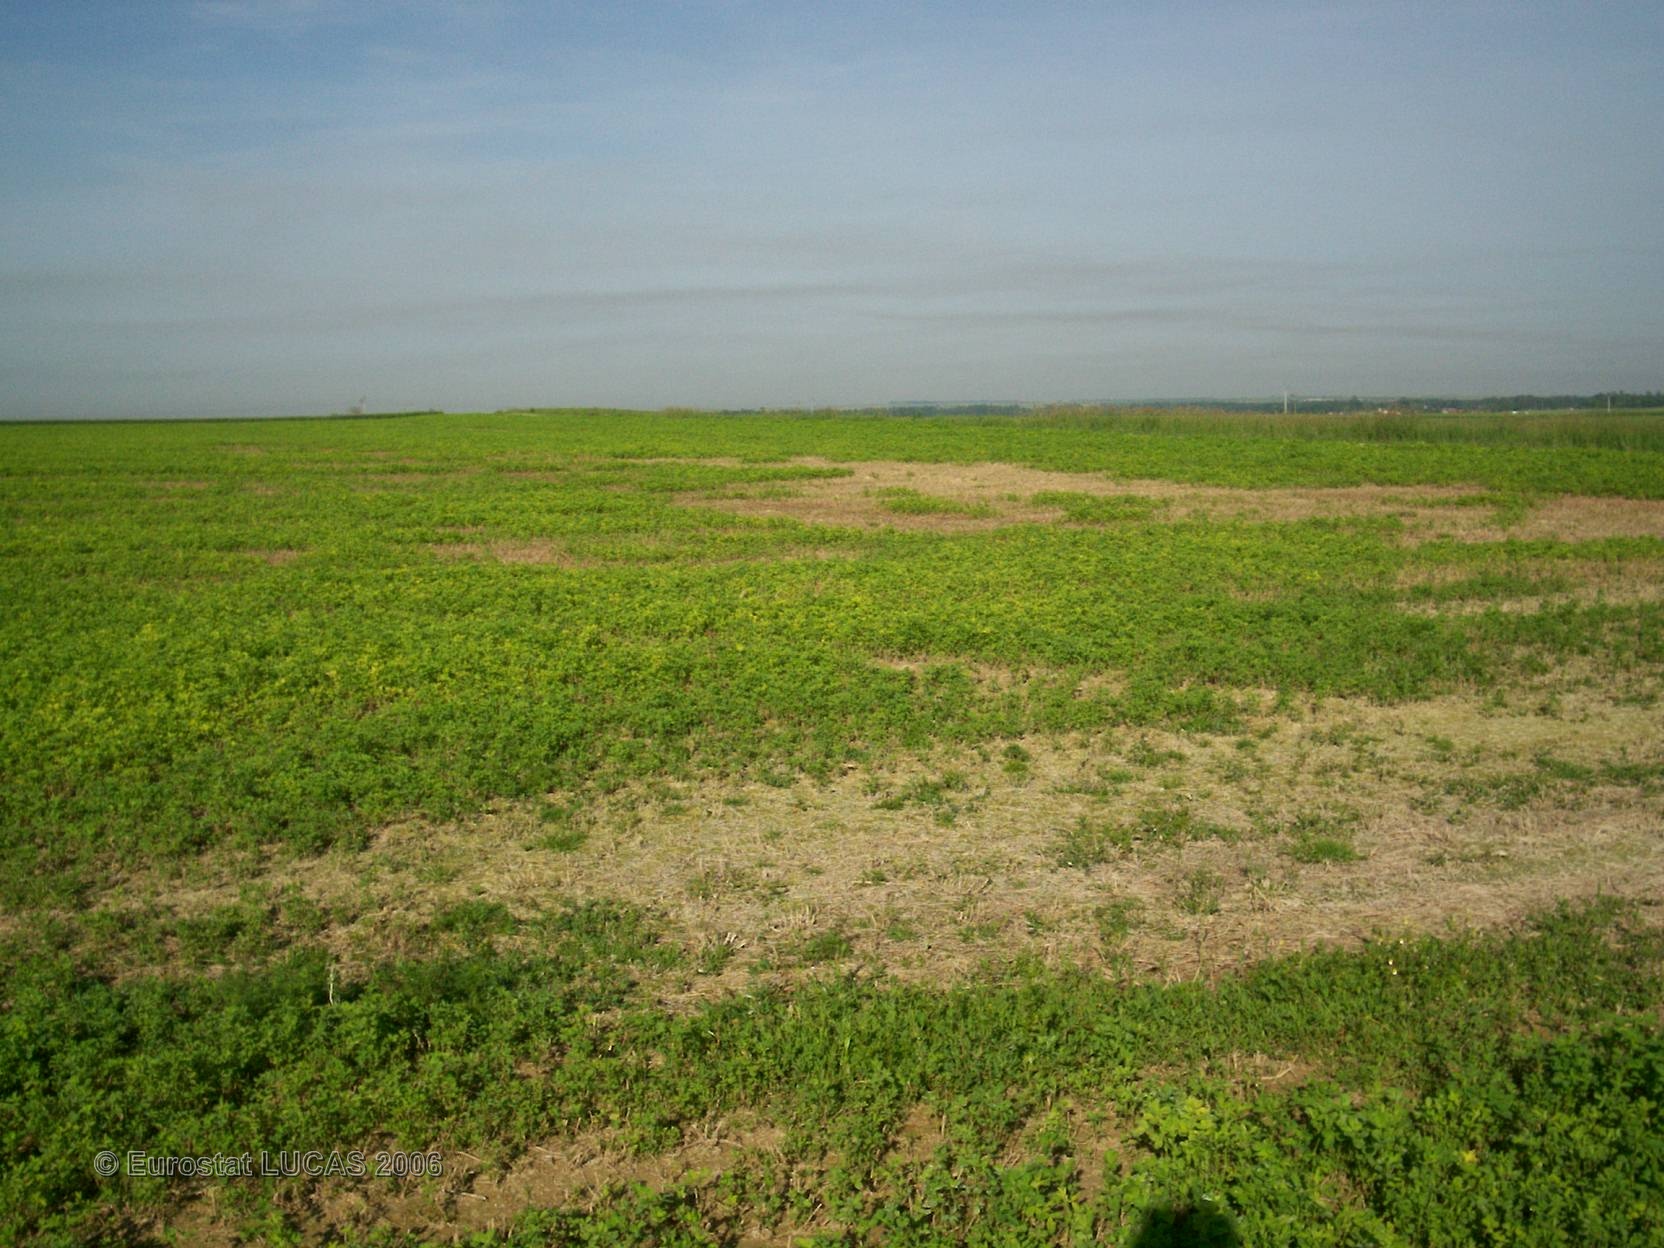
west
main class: Cropland
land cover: Lucerne
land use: Agriculture (excluding fallow land and kitchen gardens)
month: June
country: FR
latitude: 48.8964
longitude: 4.4723
